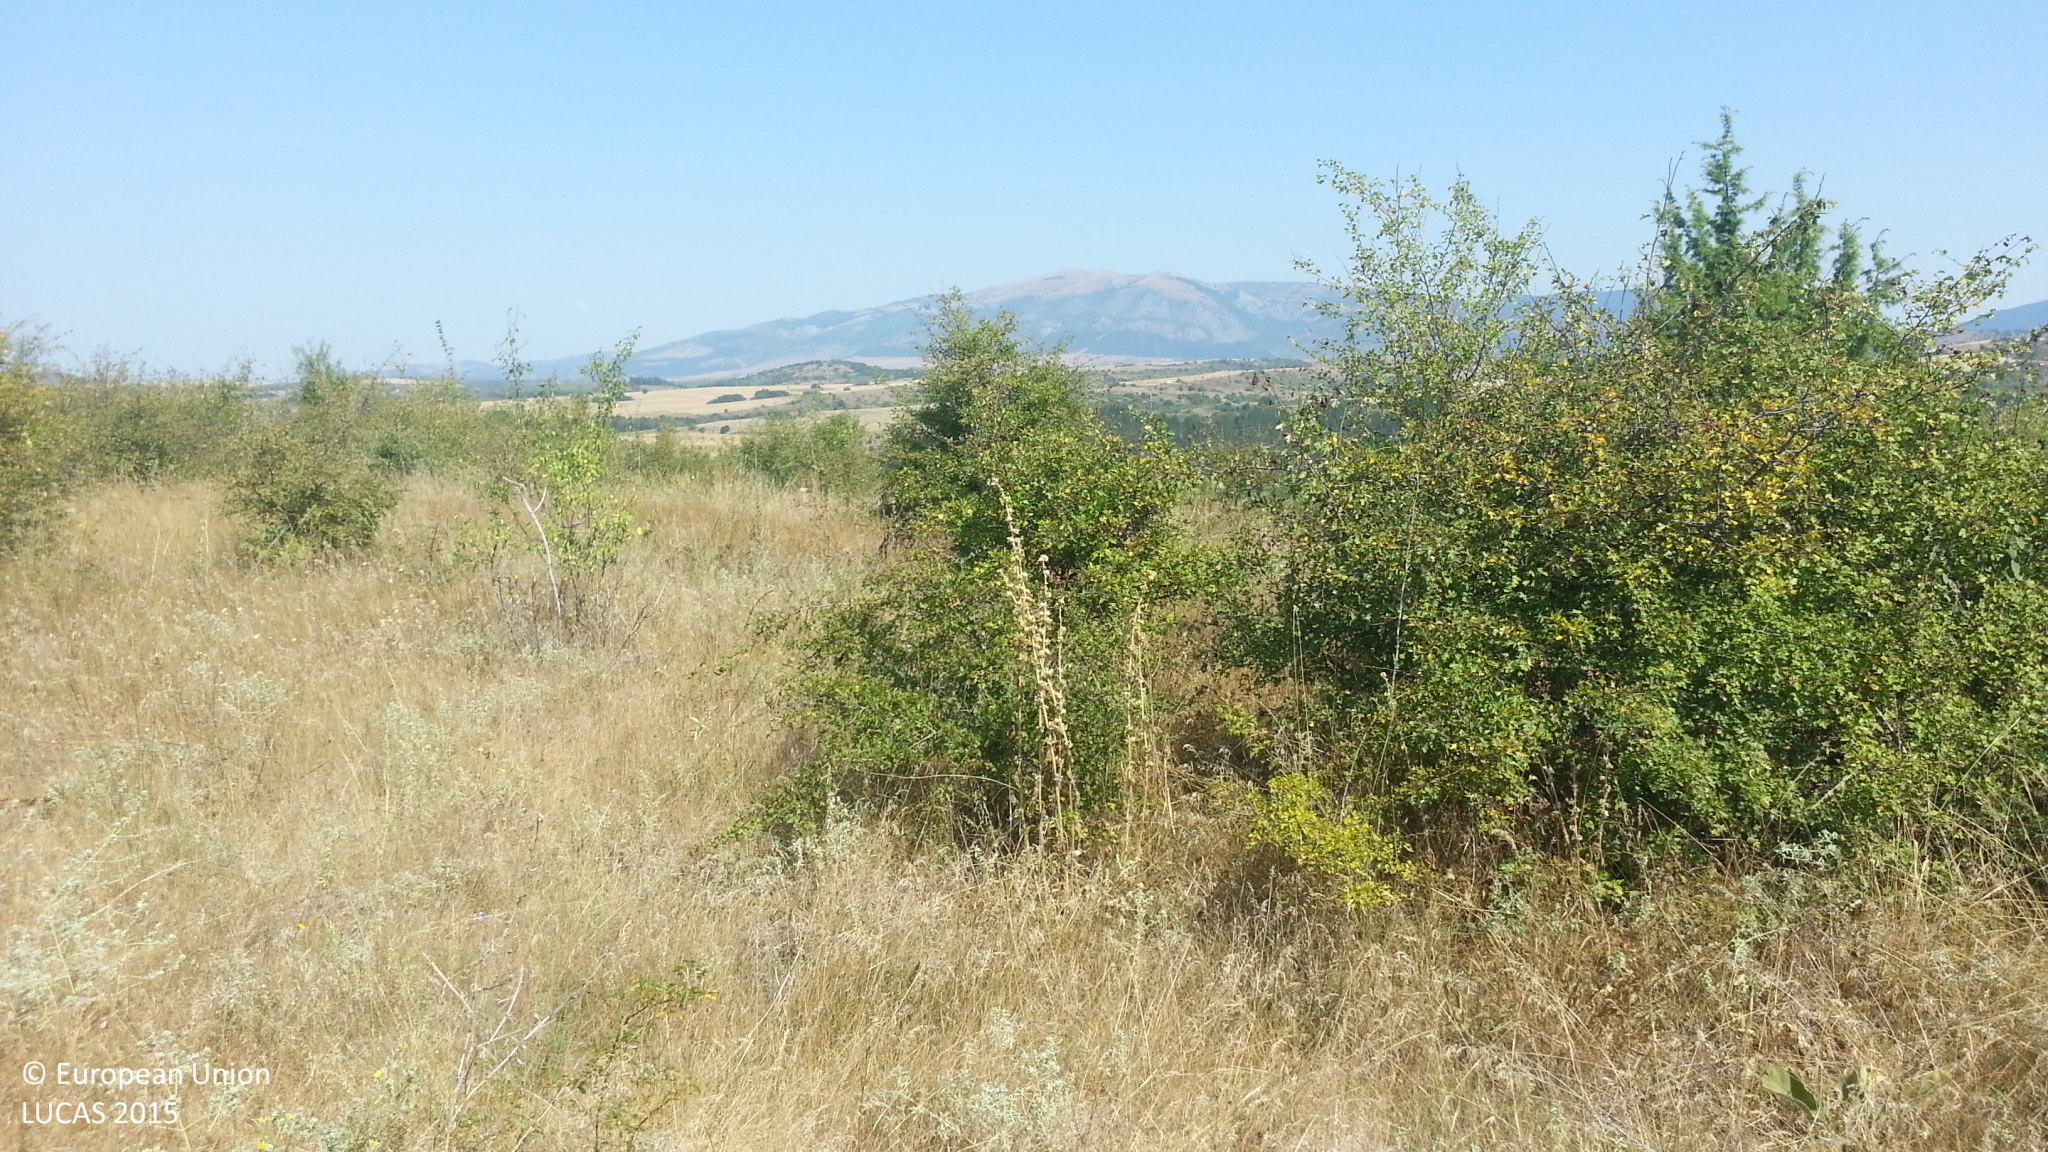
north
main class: Grassland
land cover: Grassland with sparse tree/shrub cover
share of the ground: > 75 %
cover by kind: herbaceous plants 85 %, shrubs 10 %, broadleaved forest trees 5 %
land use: Abandoned areas
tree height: < 5 m
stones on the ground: 10 - 25 %
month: August
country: BG
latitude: 42.2476
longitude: 22.8830
